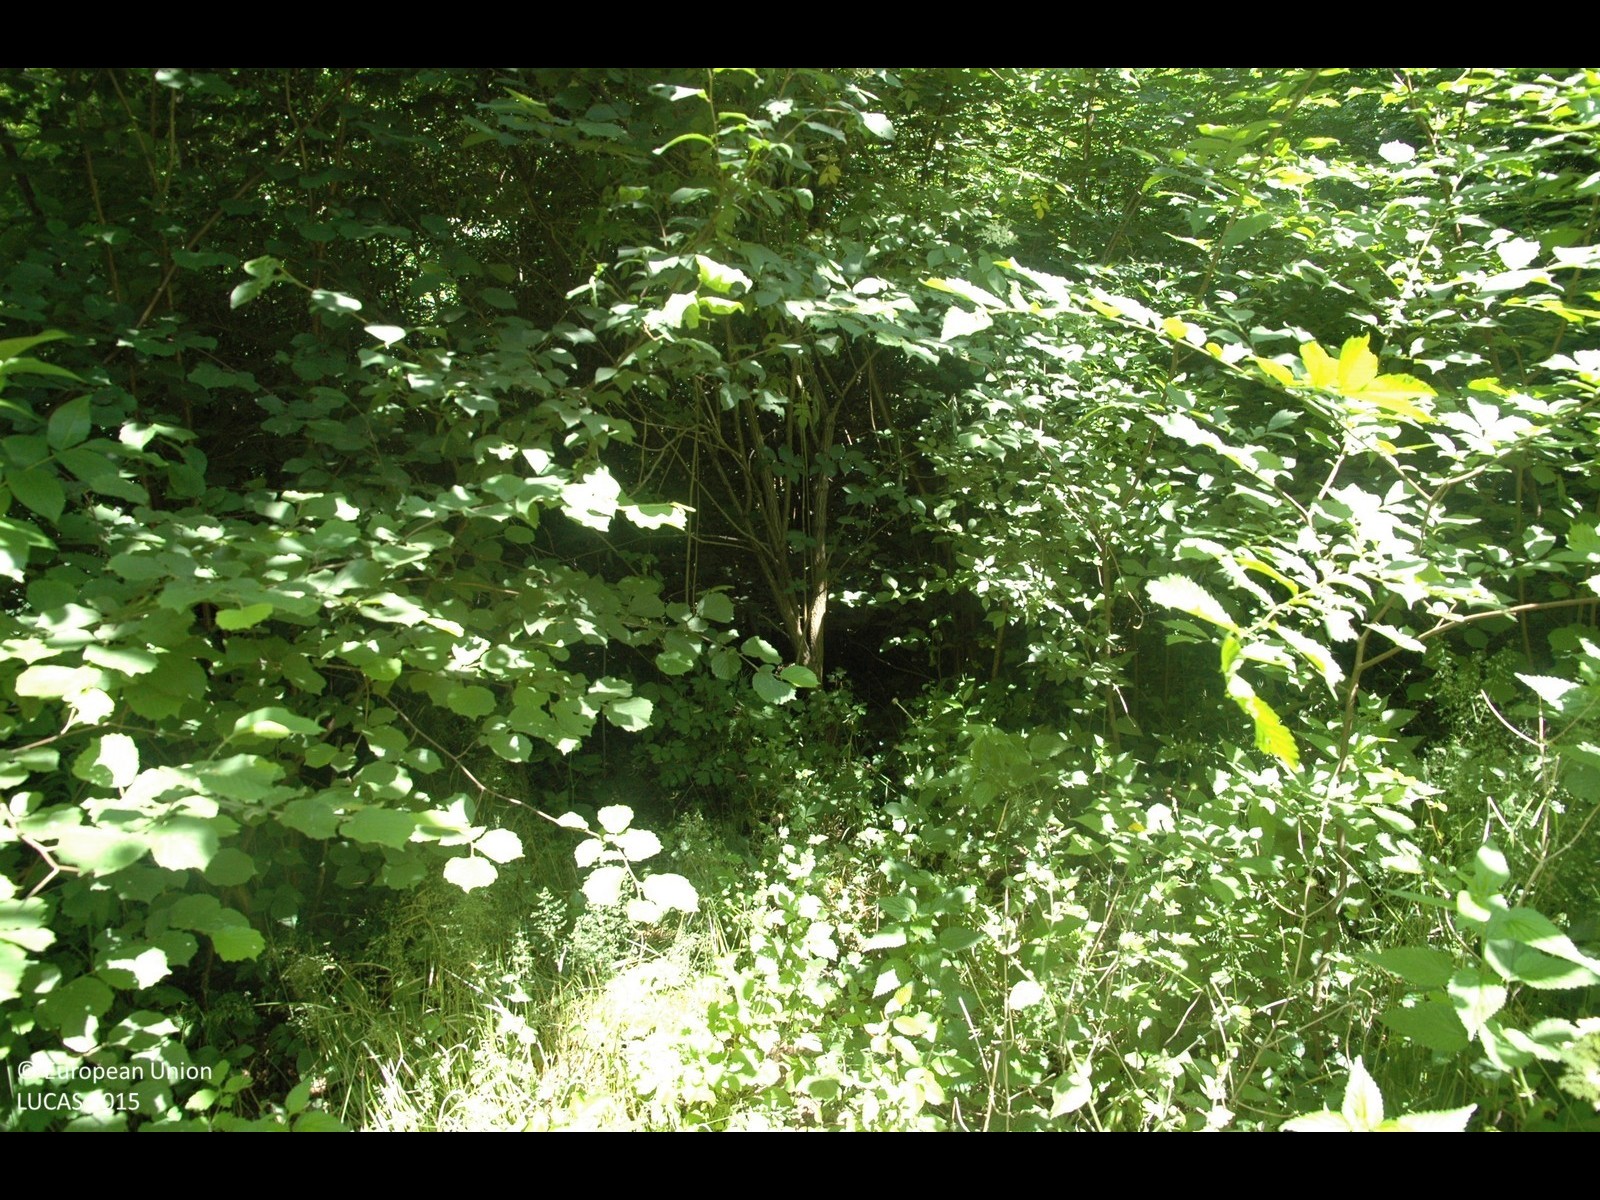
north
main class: Woodland
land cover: Broadleaved woodland
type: beech forest
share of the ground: > 75 %
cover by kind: broadleaved forest trees 90 %, shrubs 5 %, herbaceous plants 5 %
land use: Forestry
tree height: > 5 m
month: May
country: HR
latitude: 46.5238
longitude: 16.3493
